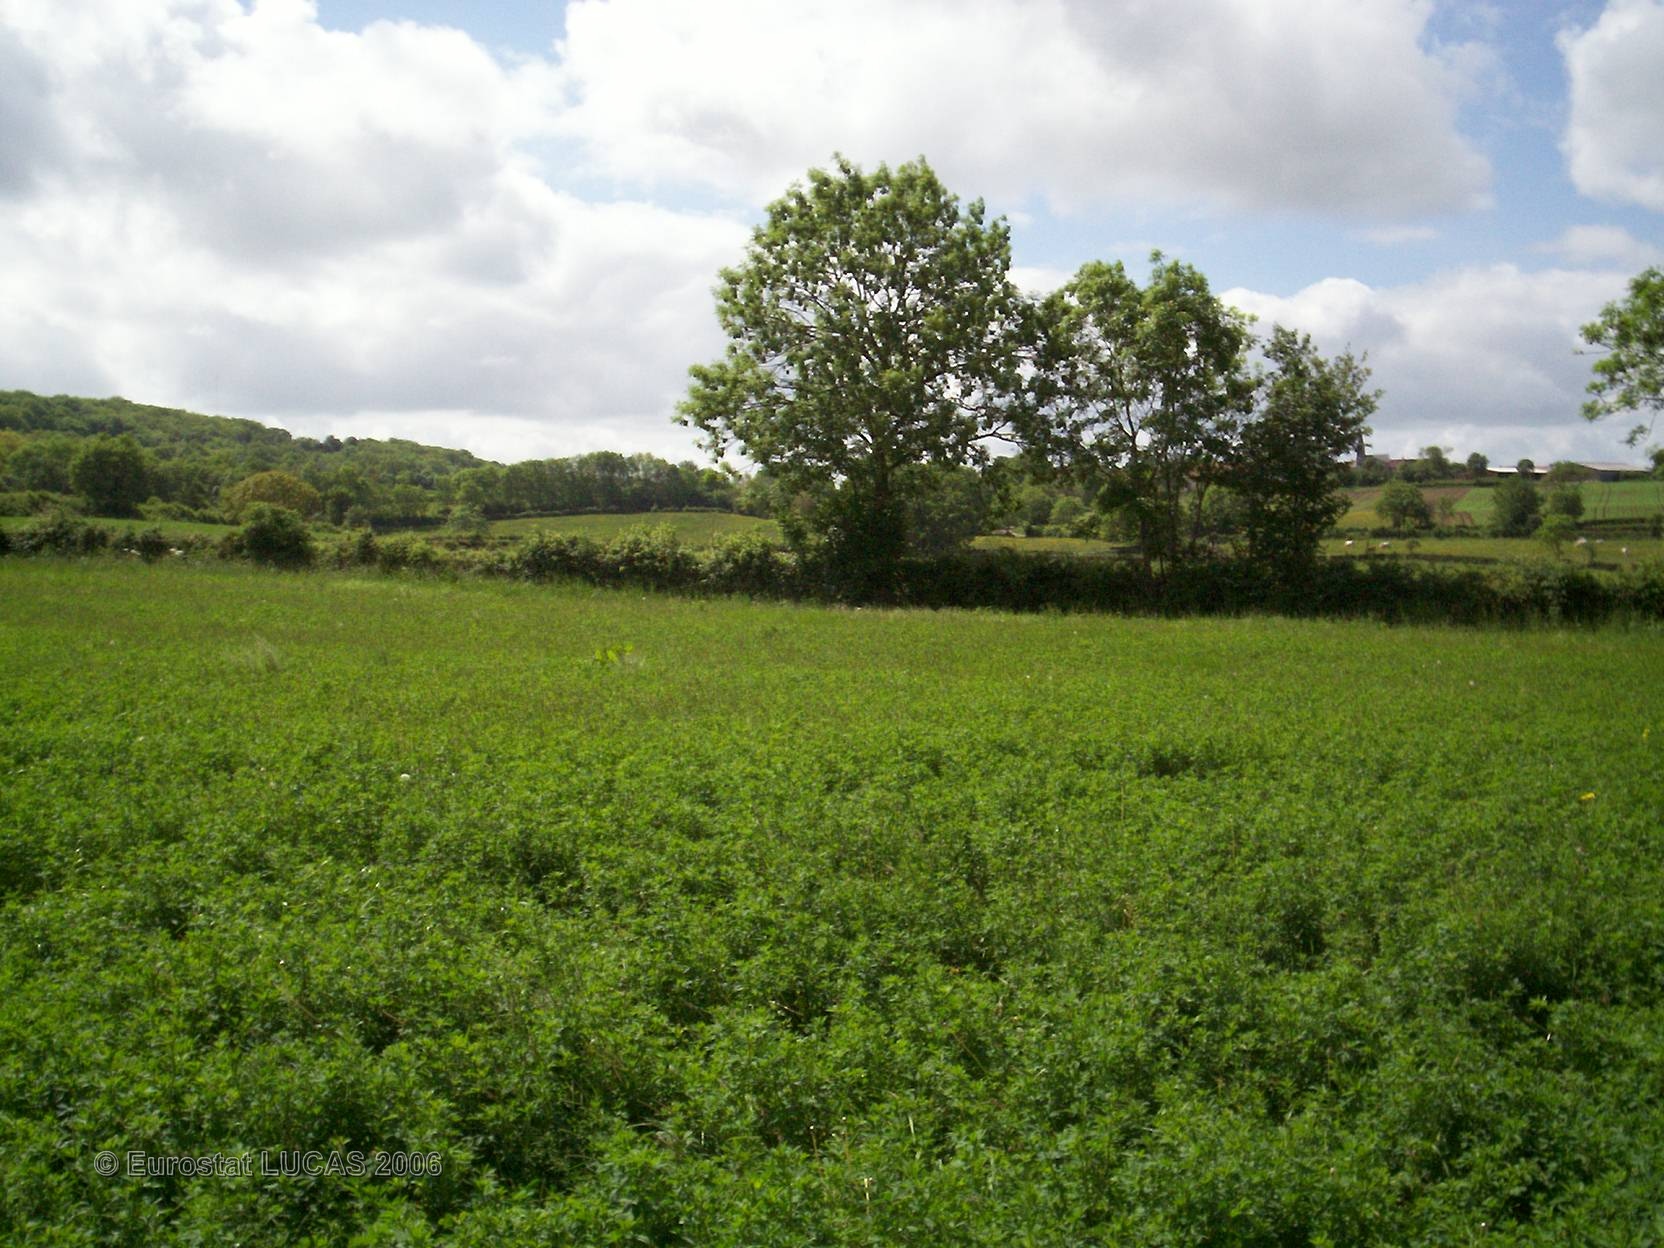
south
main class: Cropland
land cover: Lucerne
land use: Agriculture (excluding fallow land and kitchen gardens)
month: May
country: FR
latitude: 47.0471
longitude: 4.6431
